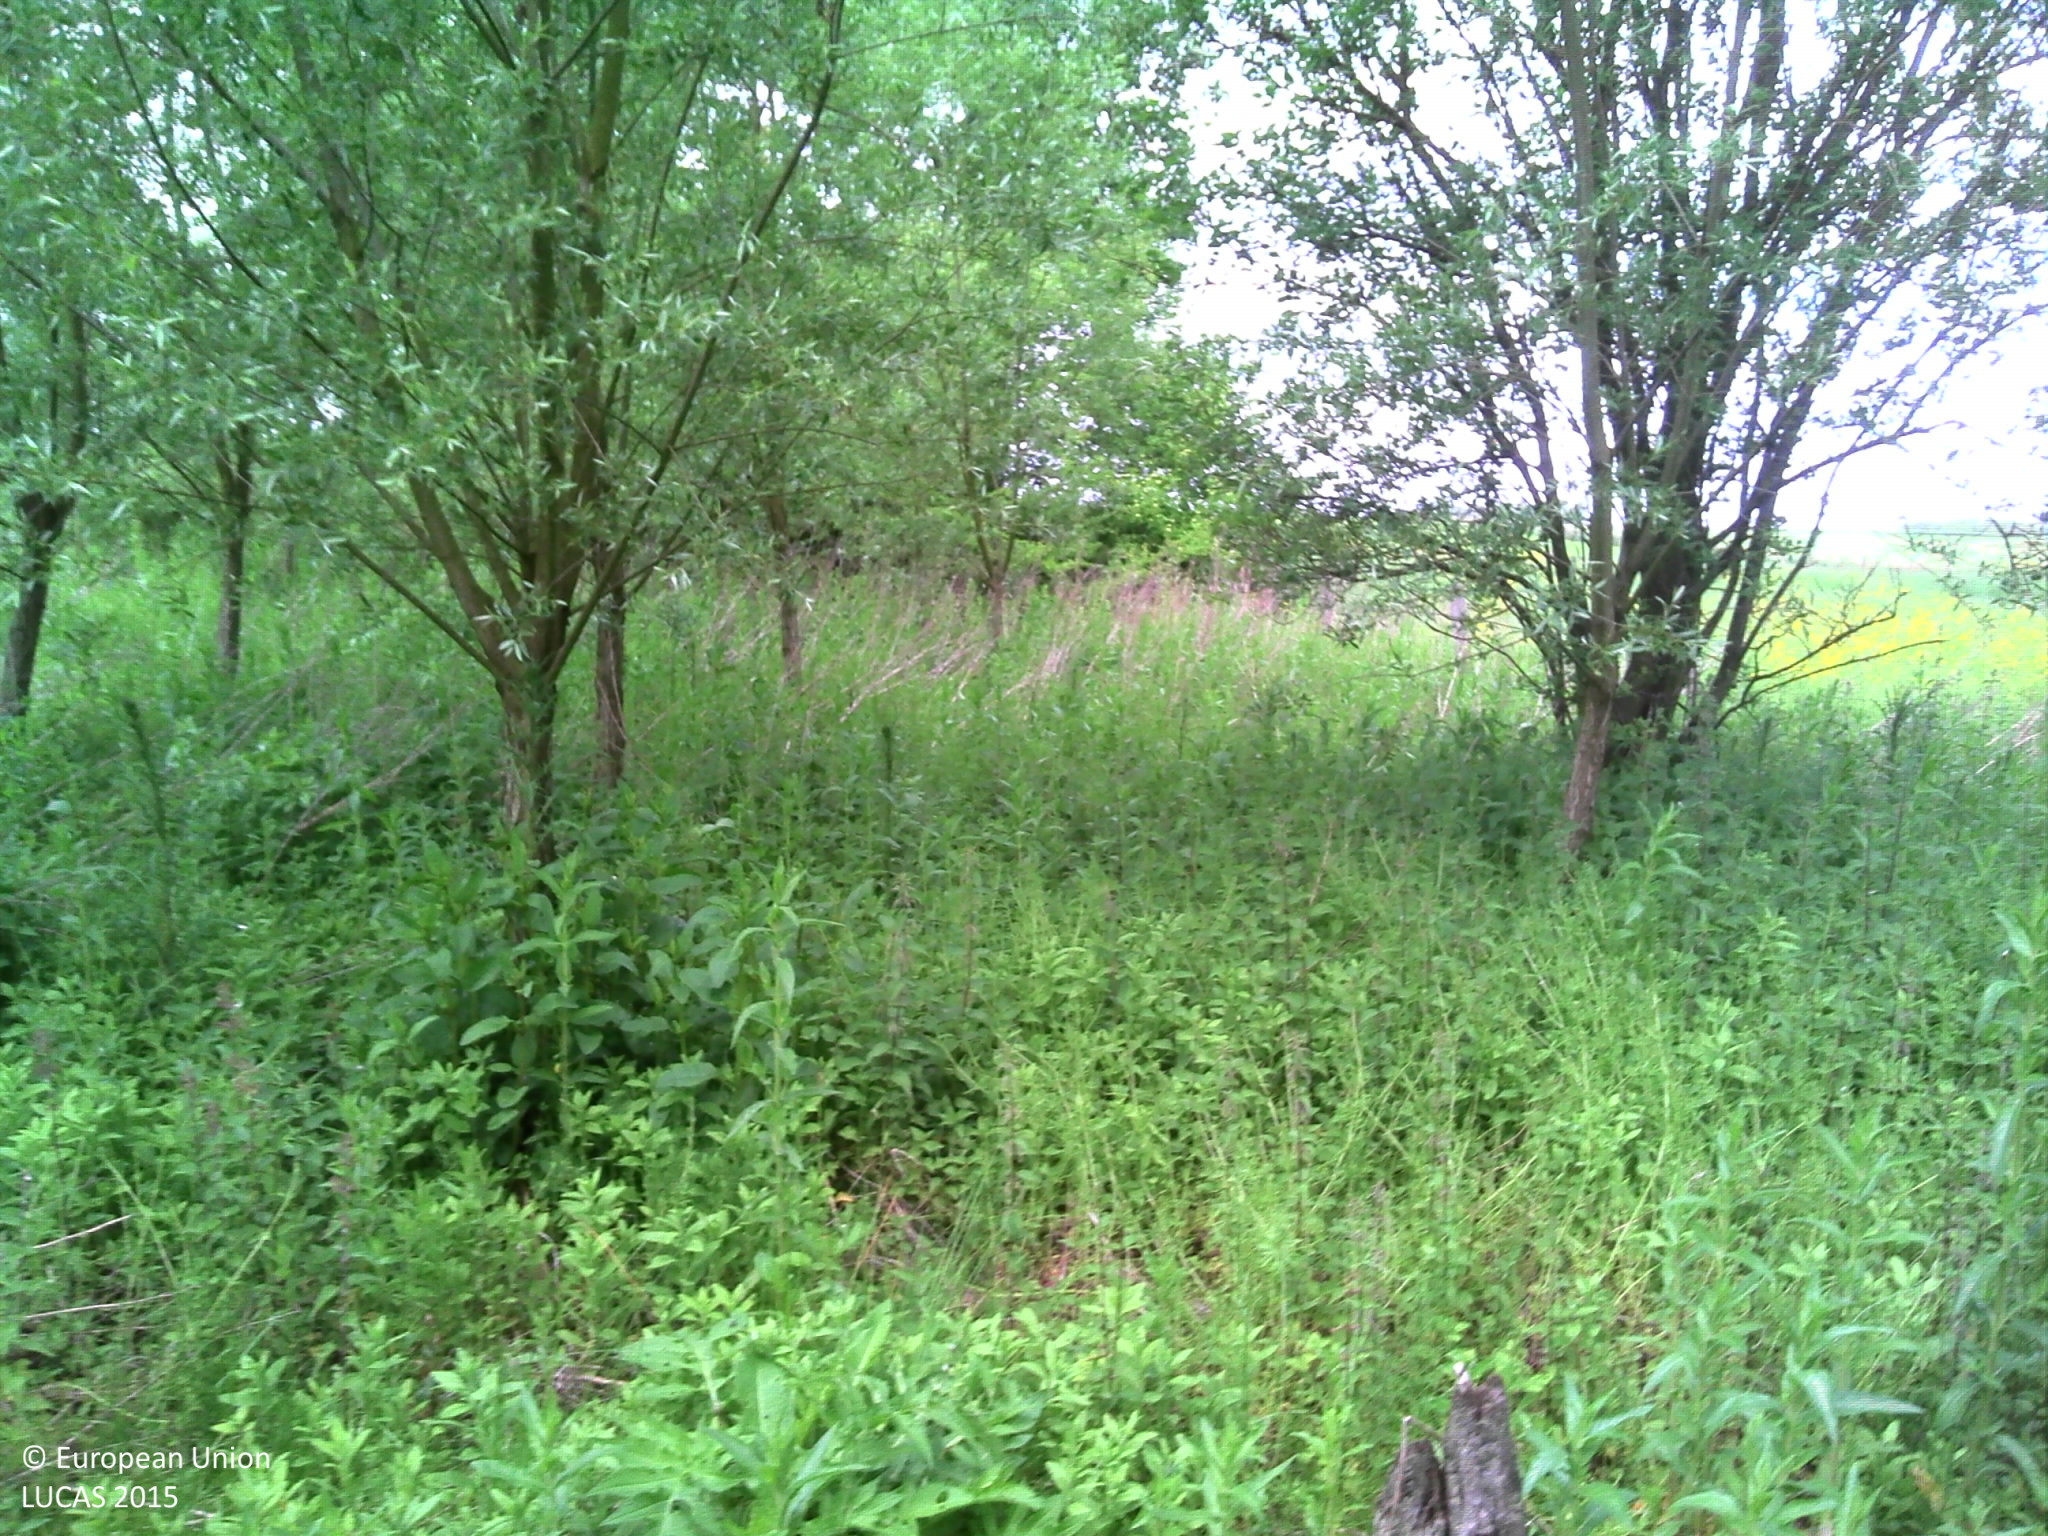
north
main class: Woodland
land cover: Broadleaved woodland
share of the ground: 50 - 75 %
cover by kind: broadleaved forest trees 60 %, herbaceous plants 40 %
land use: Forestry
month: June
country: BE
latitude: 50.7758
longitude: 3.8531
